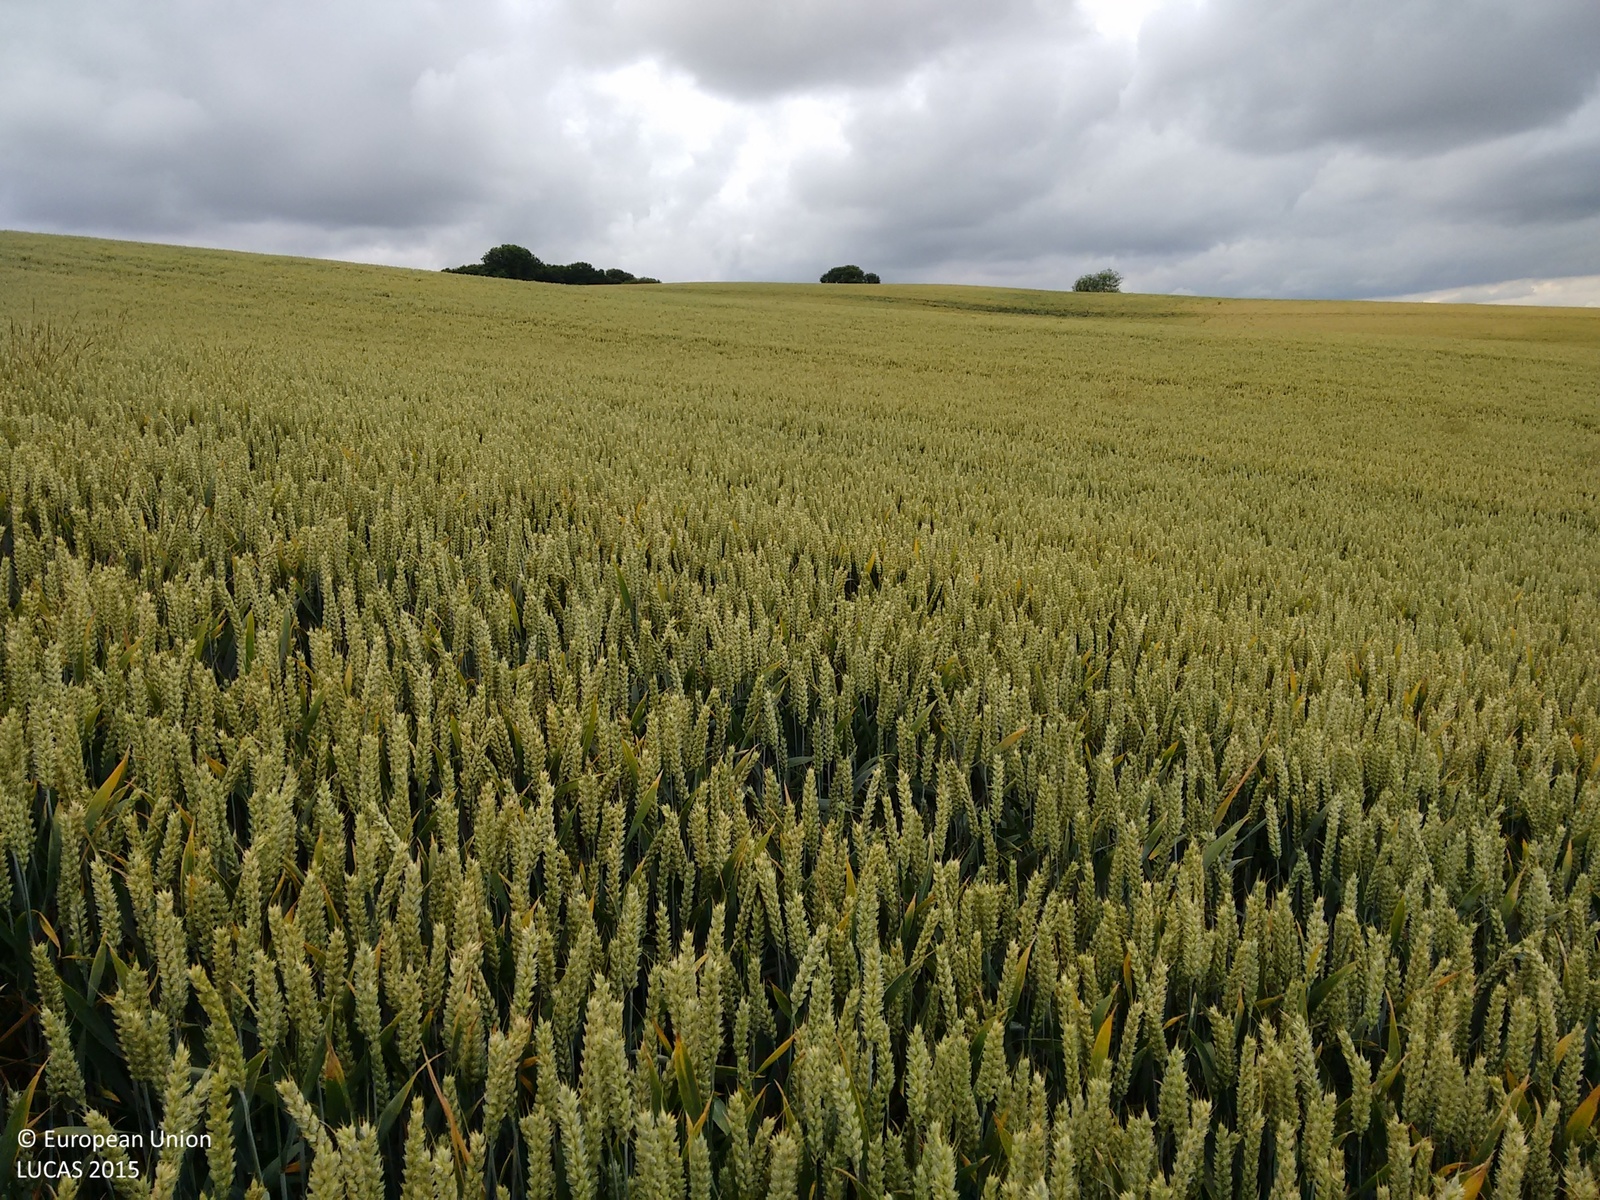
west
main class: Cropland
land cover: Common wheat
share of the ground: > 75 %
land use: Agriculture (excluding fallow land and kitchen gardens)
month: July
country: GB
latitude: 52.6126
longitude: -0.9576
